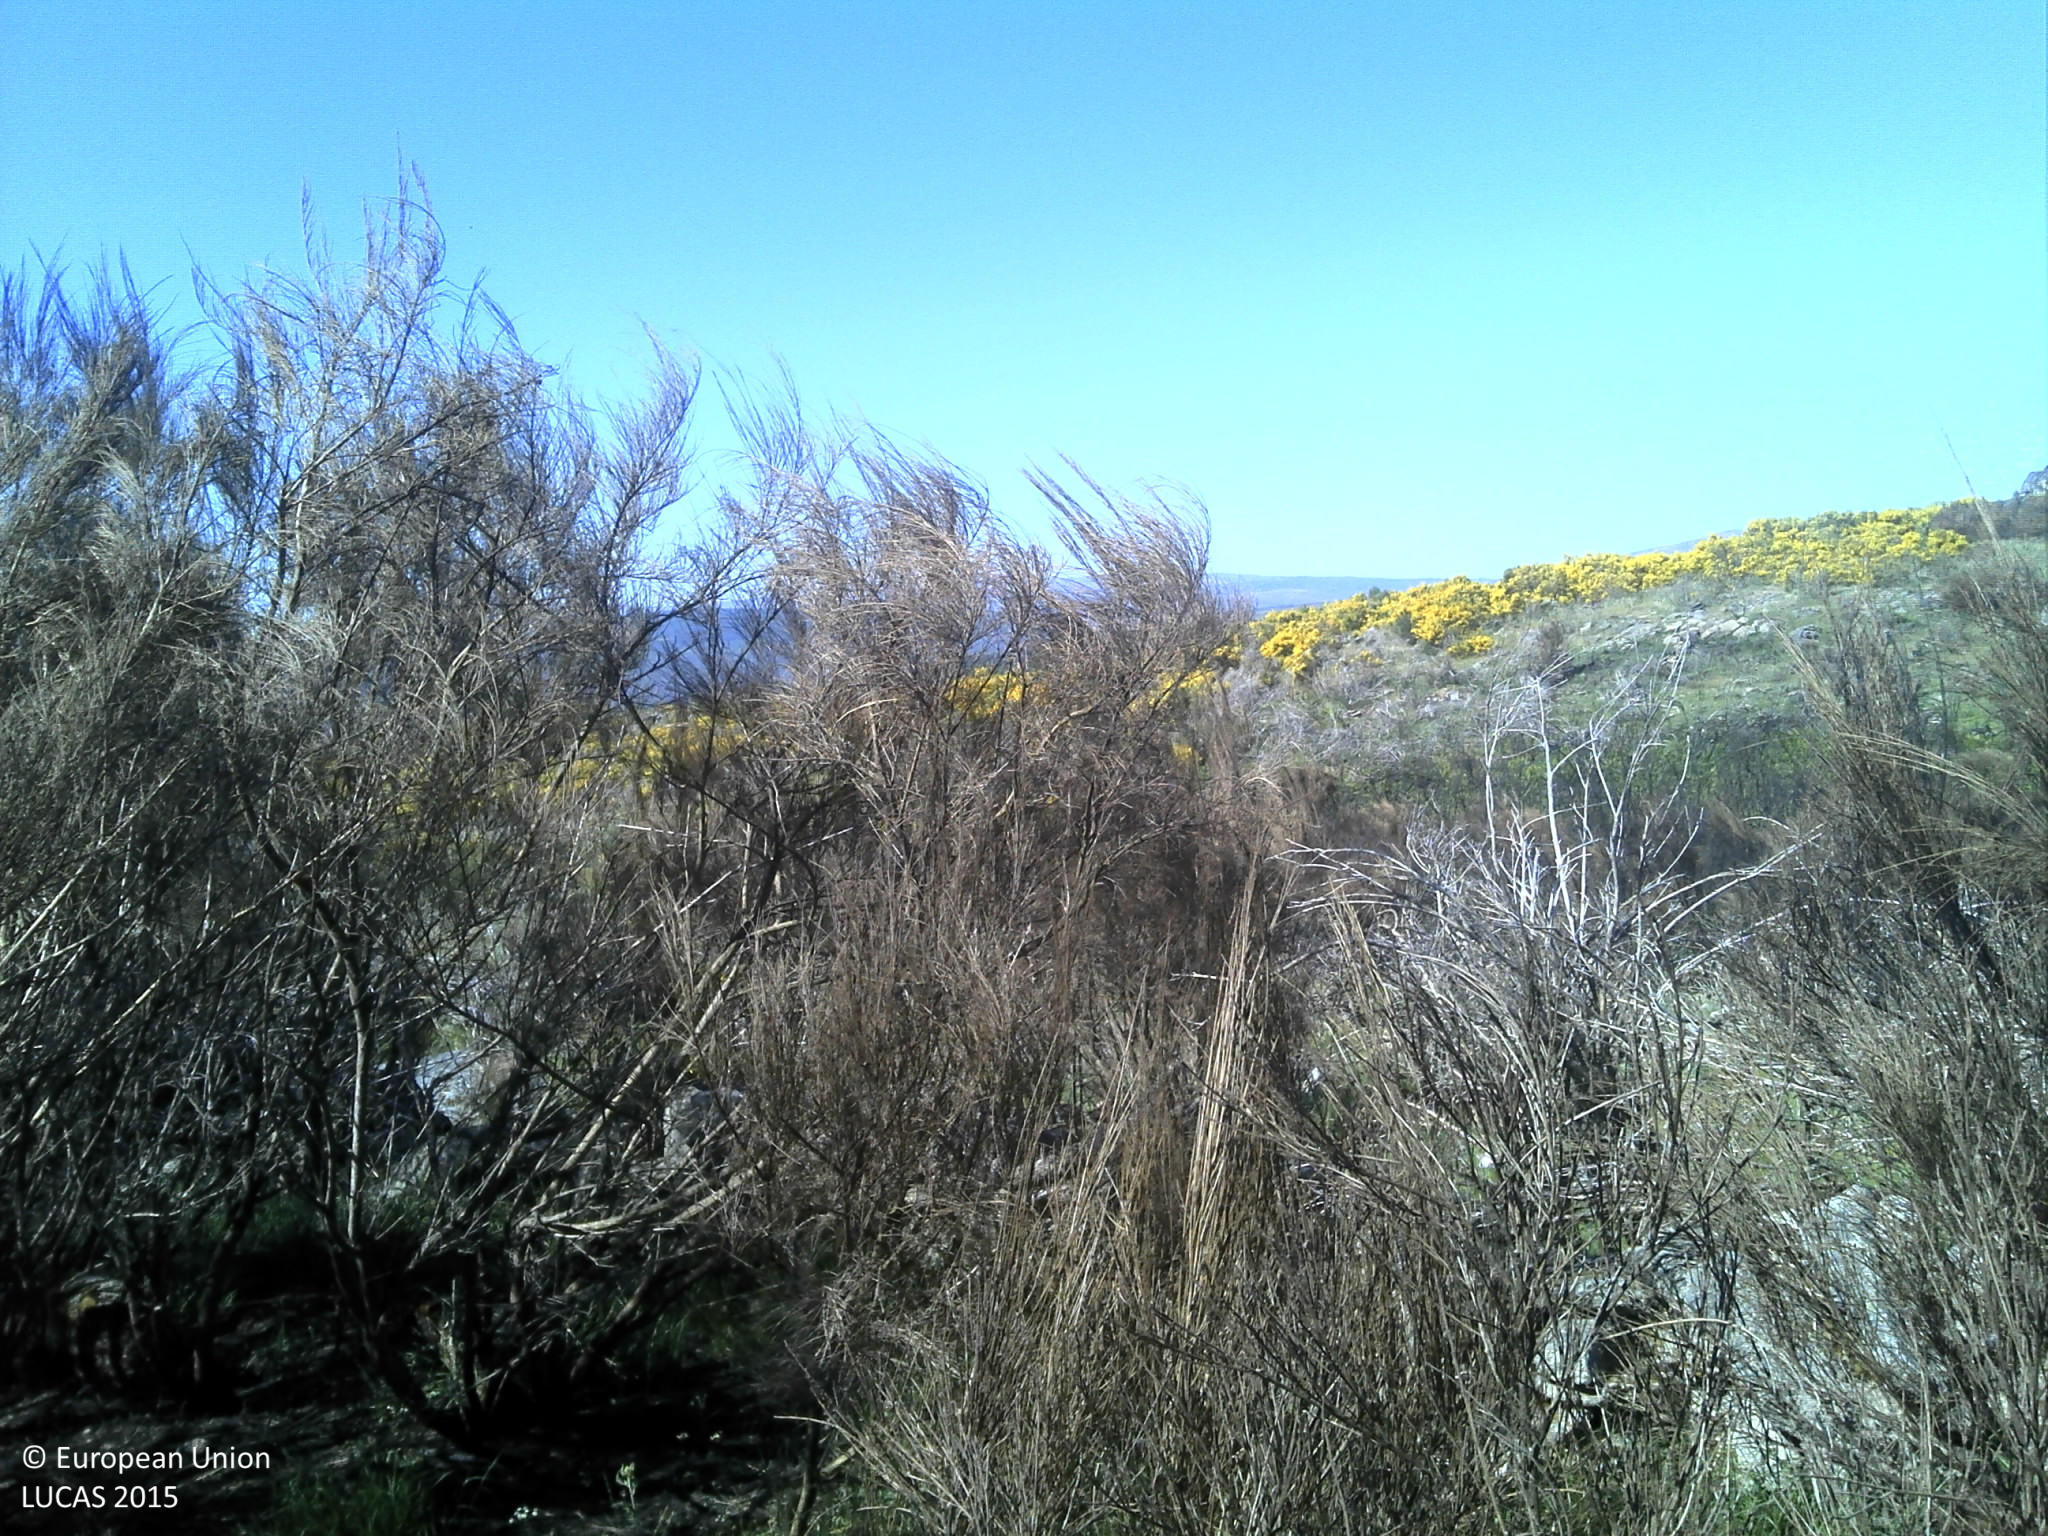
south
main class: Shrubland
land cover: Shrubland without tree cover
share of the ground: 50 - 75 %
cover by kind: shrubs 65 %, unconsolidated bare surface 20 %, herbaceous plants 5 %
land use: Semi-natural and natural areas not in use
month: May
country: PT
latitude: 40.5295
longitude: -7.3791
